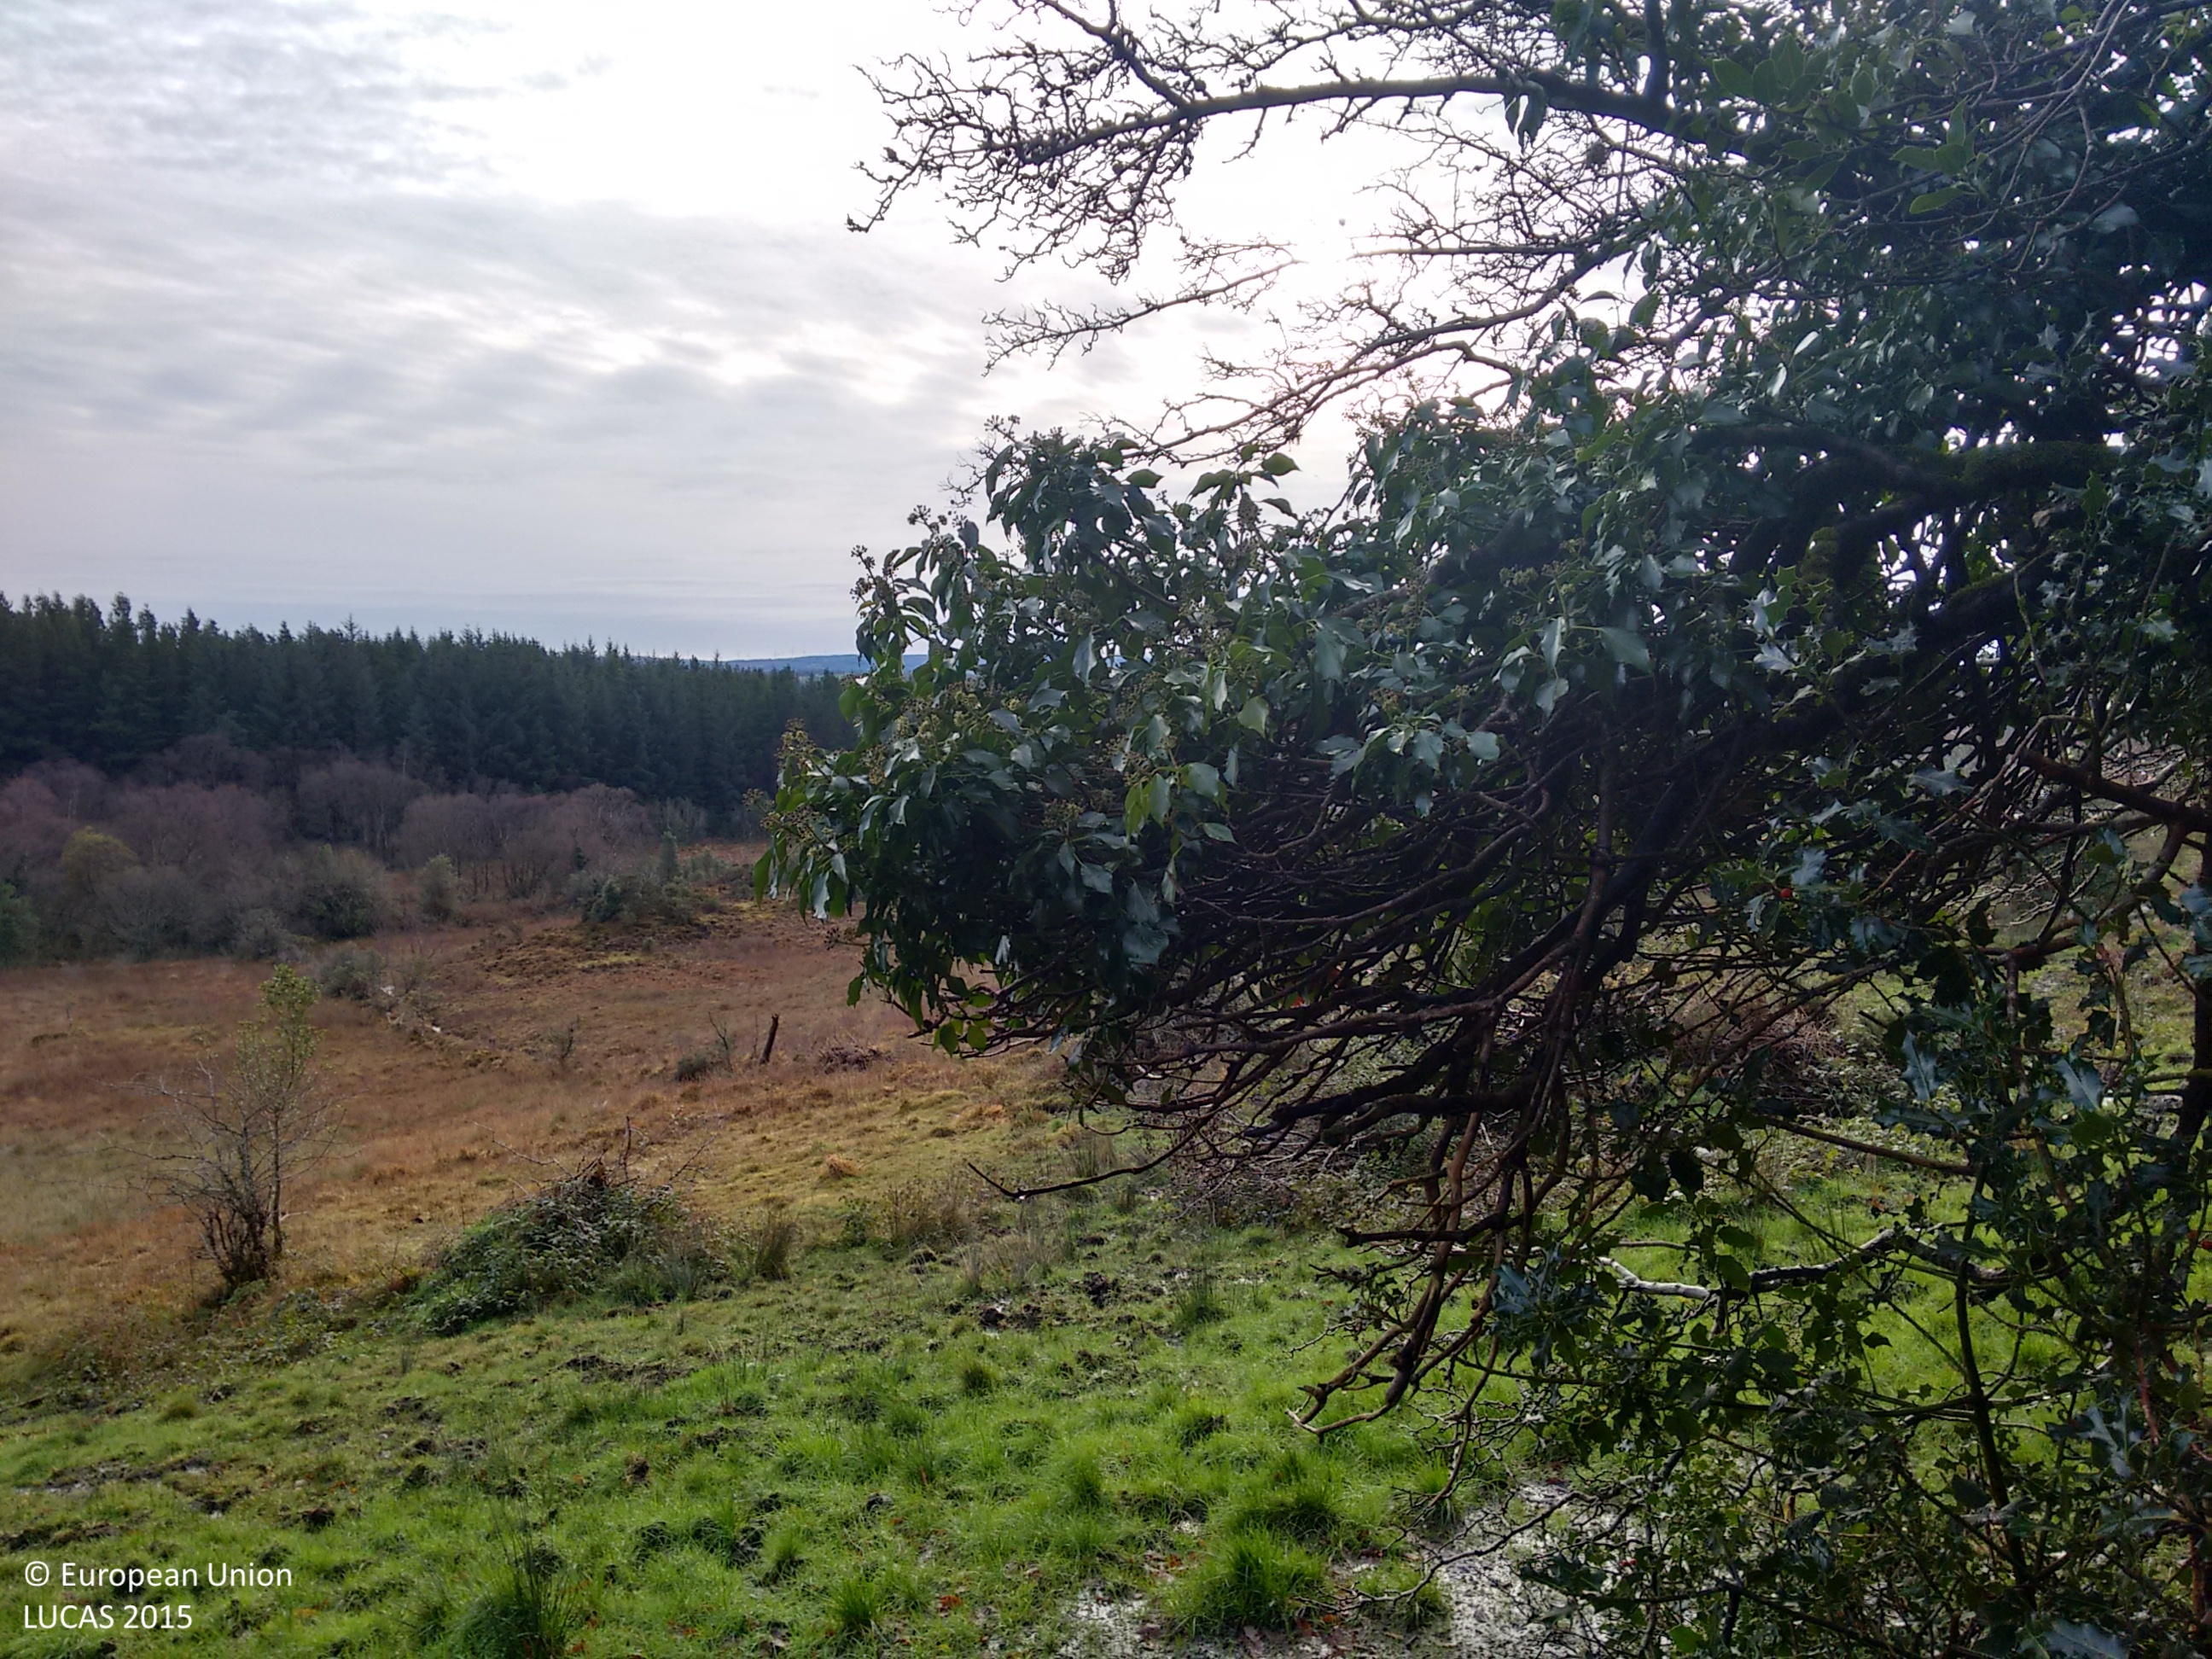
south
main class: Woodland
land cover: Spruce dominated coniferous woodland
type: exotic forest
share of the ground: > 75 %
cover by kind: coniferous forest trees 100 %
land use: Forestry
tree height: > 5 m
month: November
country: IE
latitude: 54.2732
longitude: -8.2254
